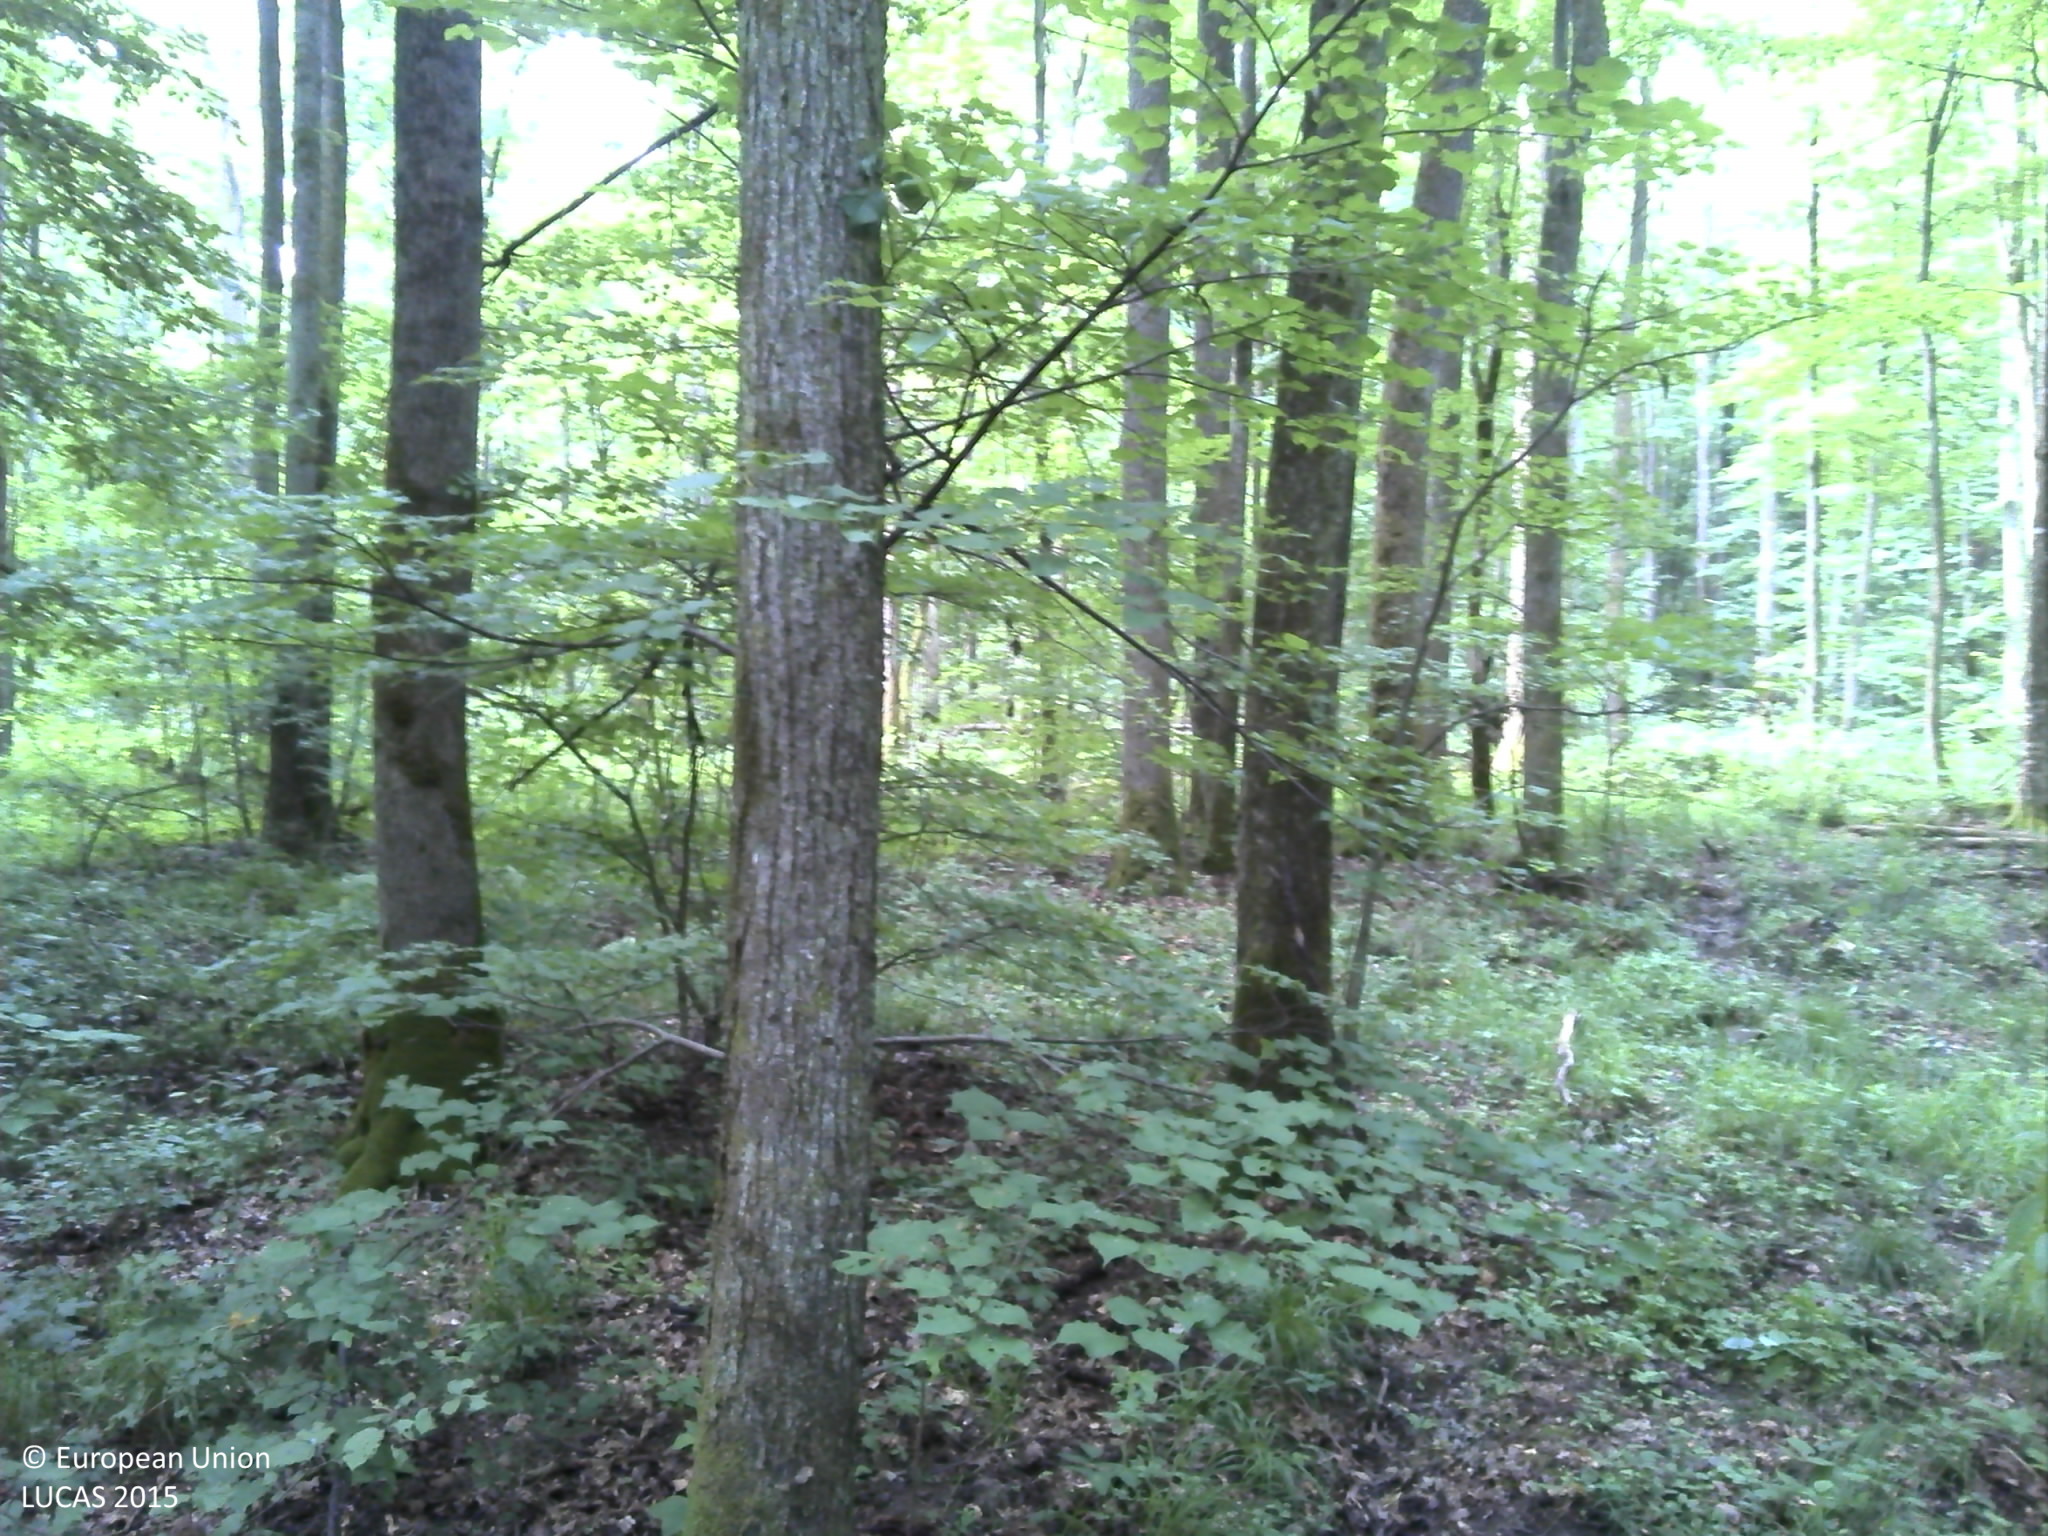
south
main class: Woodland
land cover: Broadleaved woodland
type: beech forest
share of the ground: > 75 %
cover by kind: broadleaved forest trees 100 %
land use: Forestry
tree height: > 5 m
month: June
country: HR
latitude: 45.6691
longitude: 18.0271
